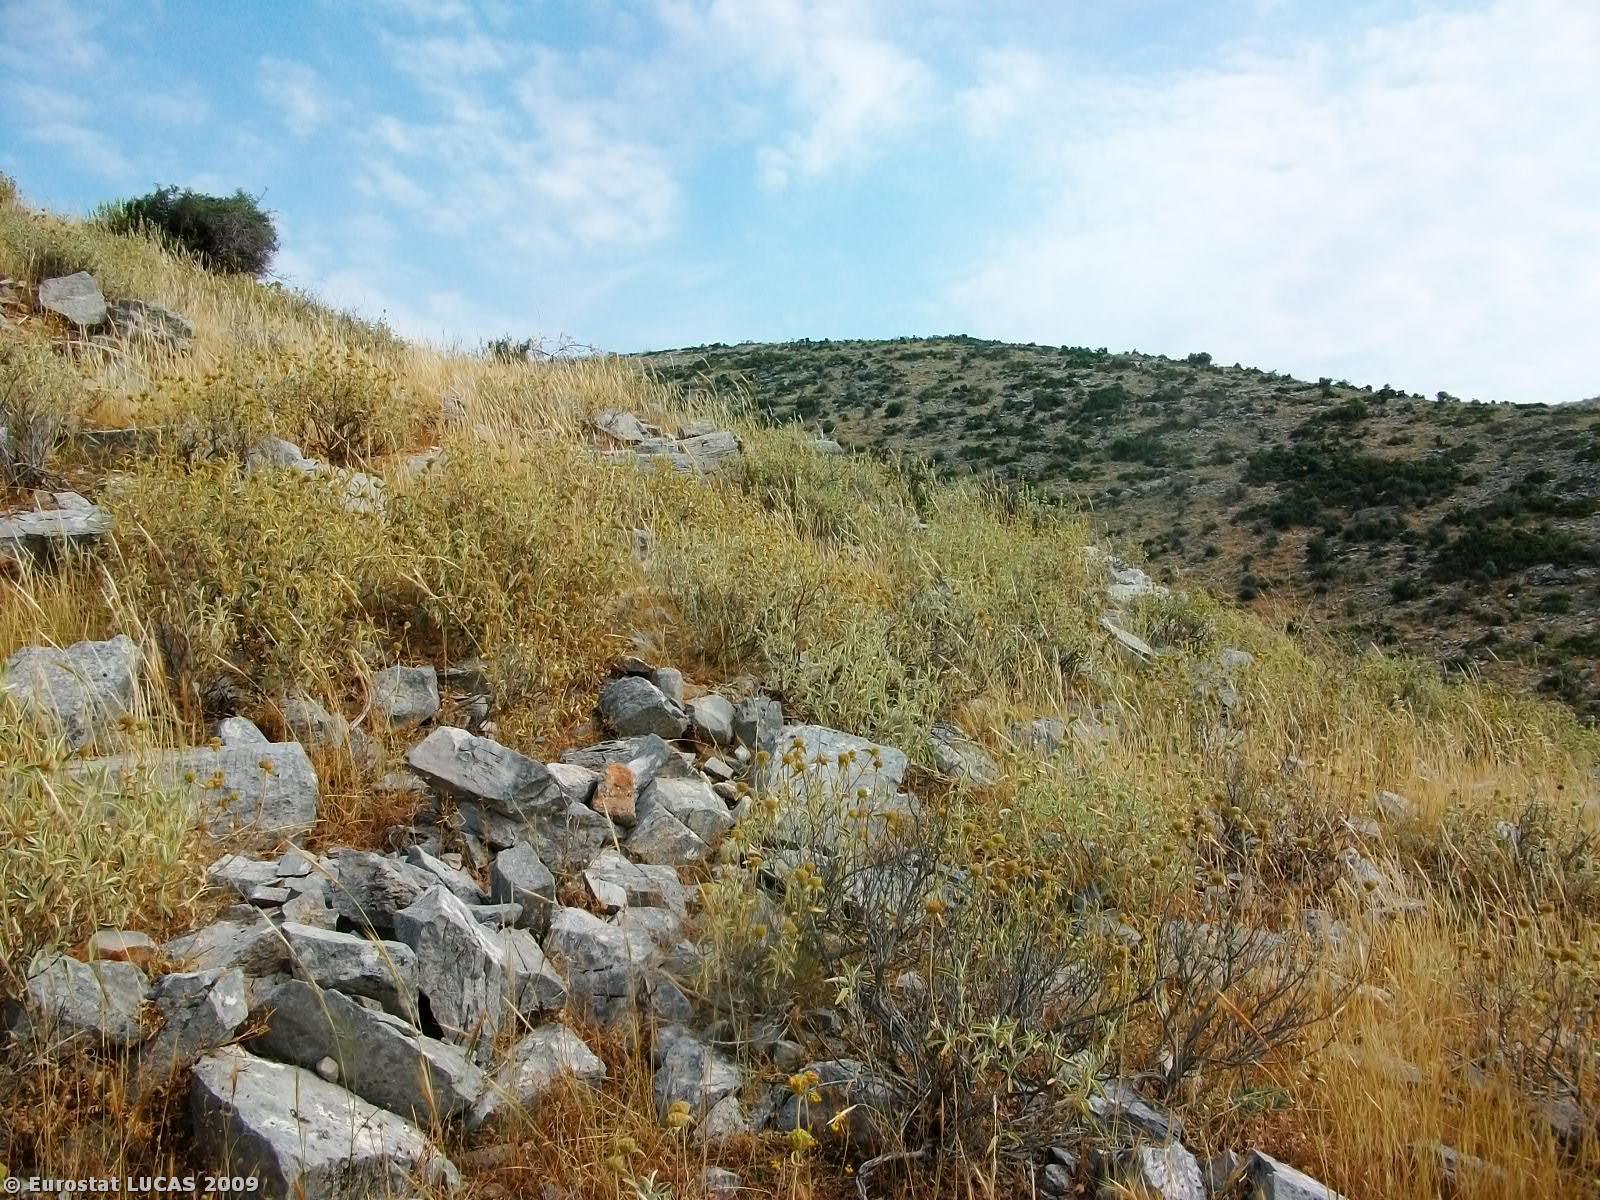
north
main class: Shrubland
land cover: Shrubland without tree cover
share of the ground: 50 - 75 %
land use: Agriculture (excluding fallow land and kitchen gardens)
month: May
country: GR
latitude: 39.4068
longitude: 22.8002
